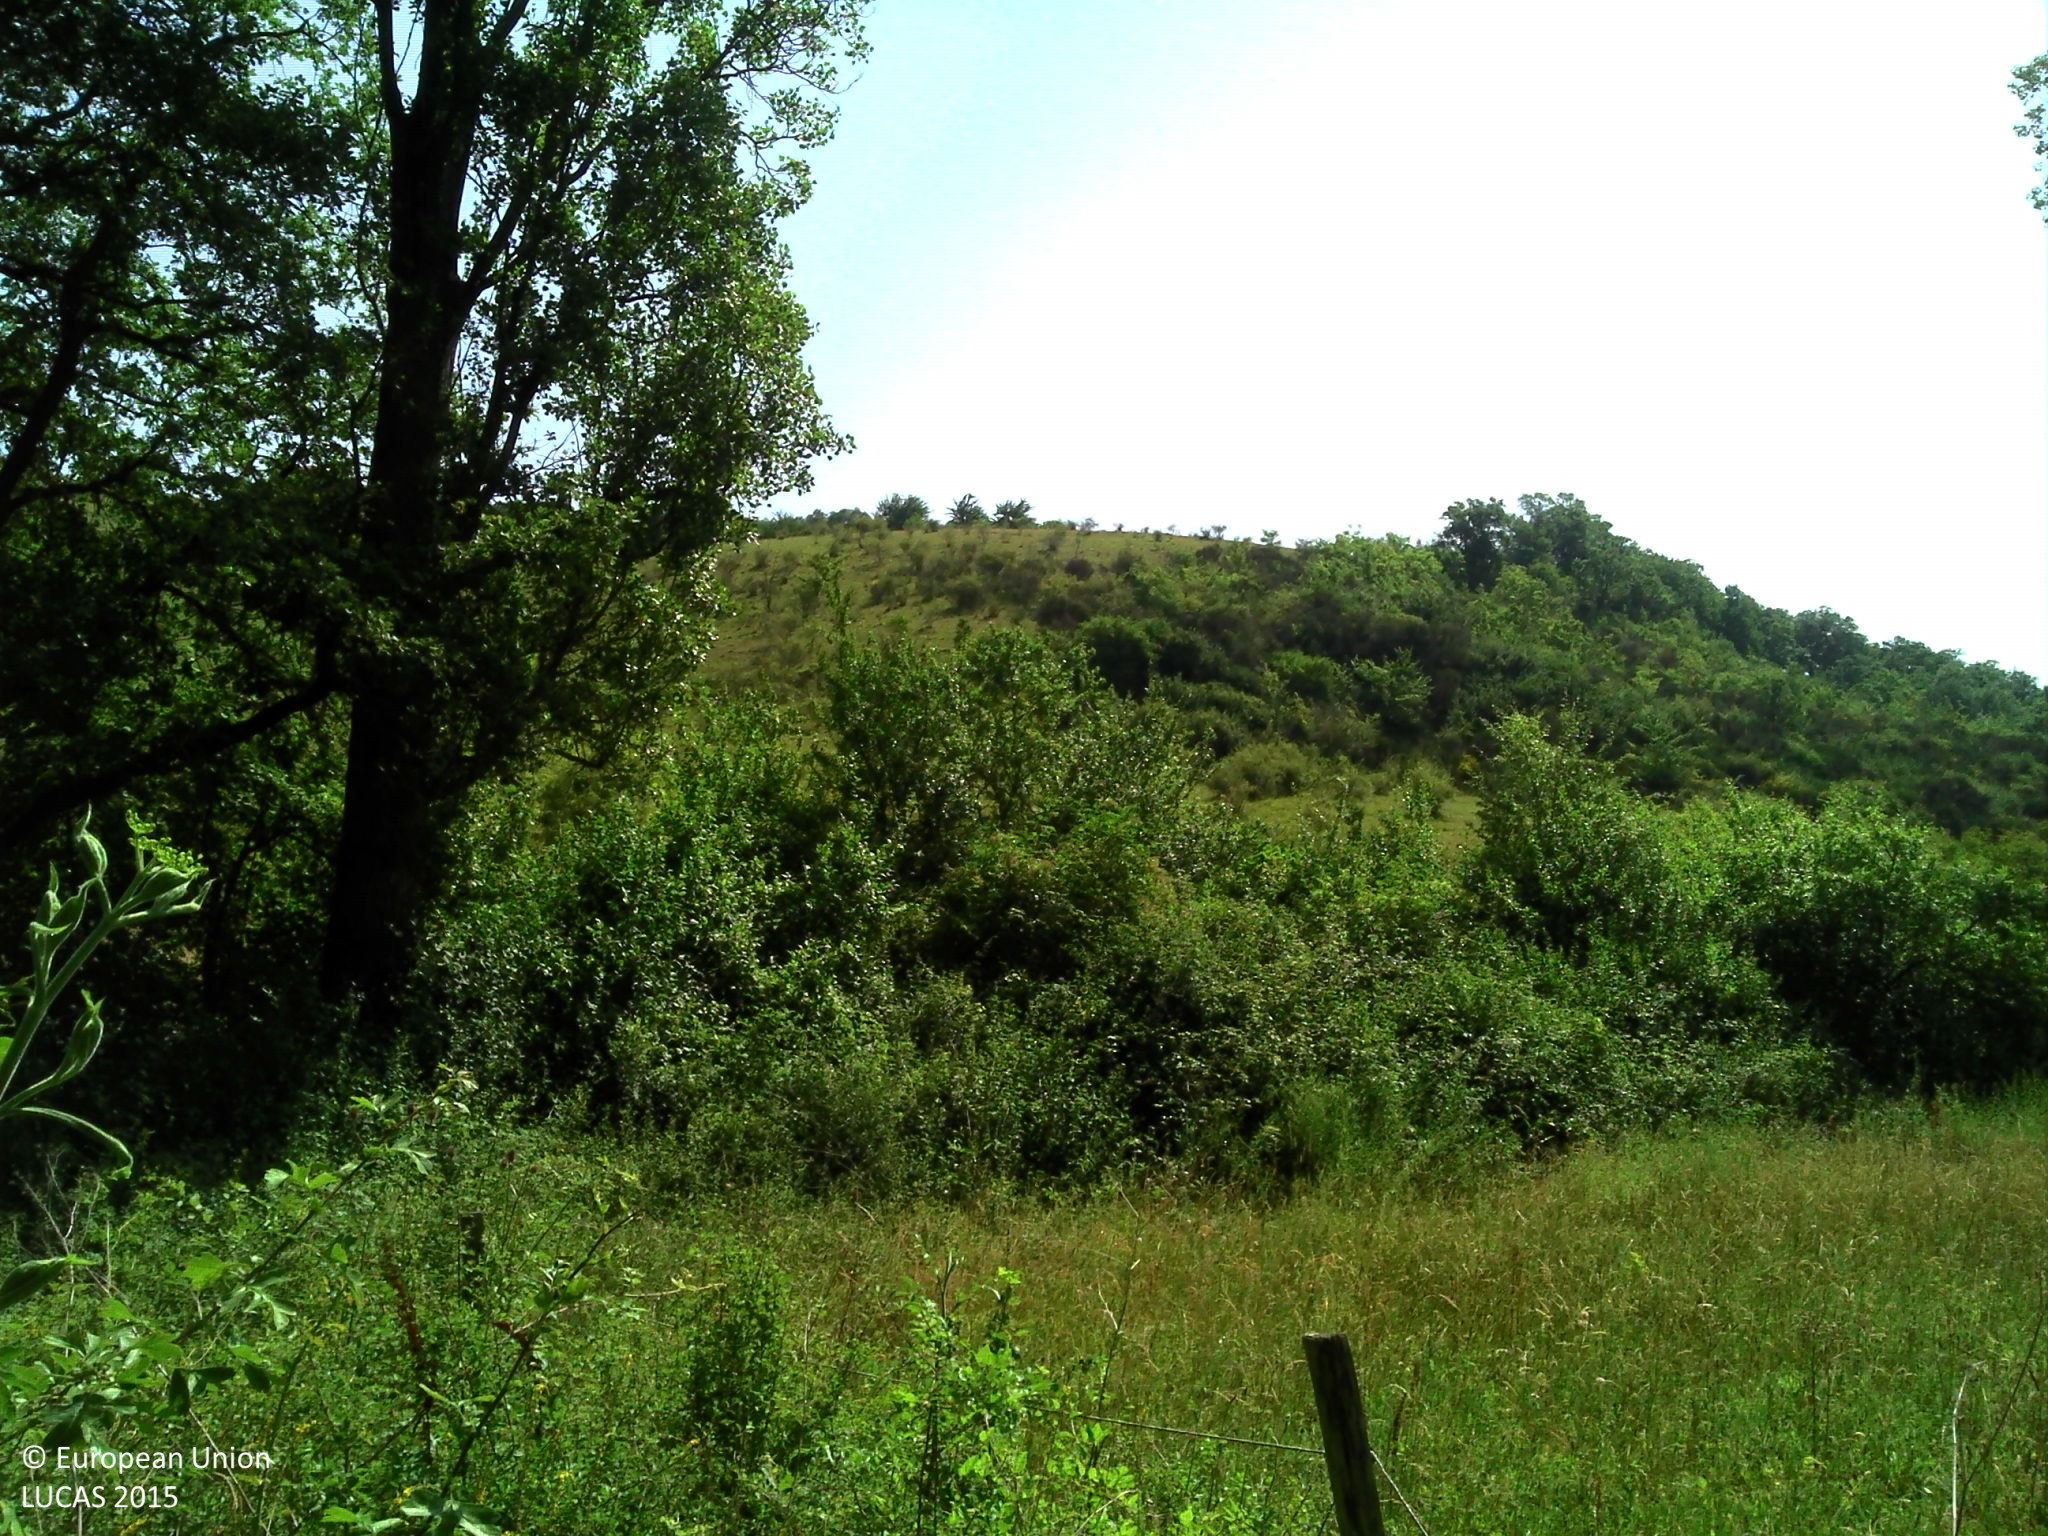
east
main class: Grassland
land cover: Spontaneously vegetated surfaces
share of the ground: > 75 %
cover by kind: herbaceous plants 100 %
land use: Semi-natural and natural areas not in use
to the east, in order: Spontaneously vegetated surfaces; Fences; Grassland without tree/shrub cover; Abandoned hedges; Rivers and streams; Barley; Shrubland without tree cover
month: July
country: FR
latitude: 43.1953
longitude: 1.4030
